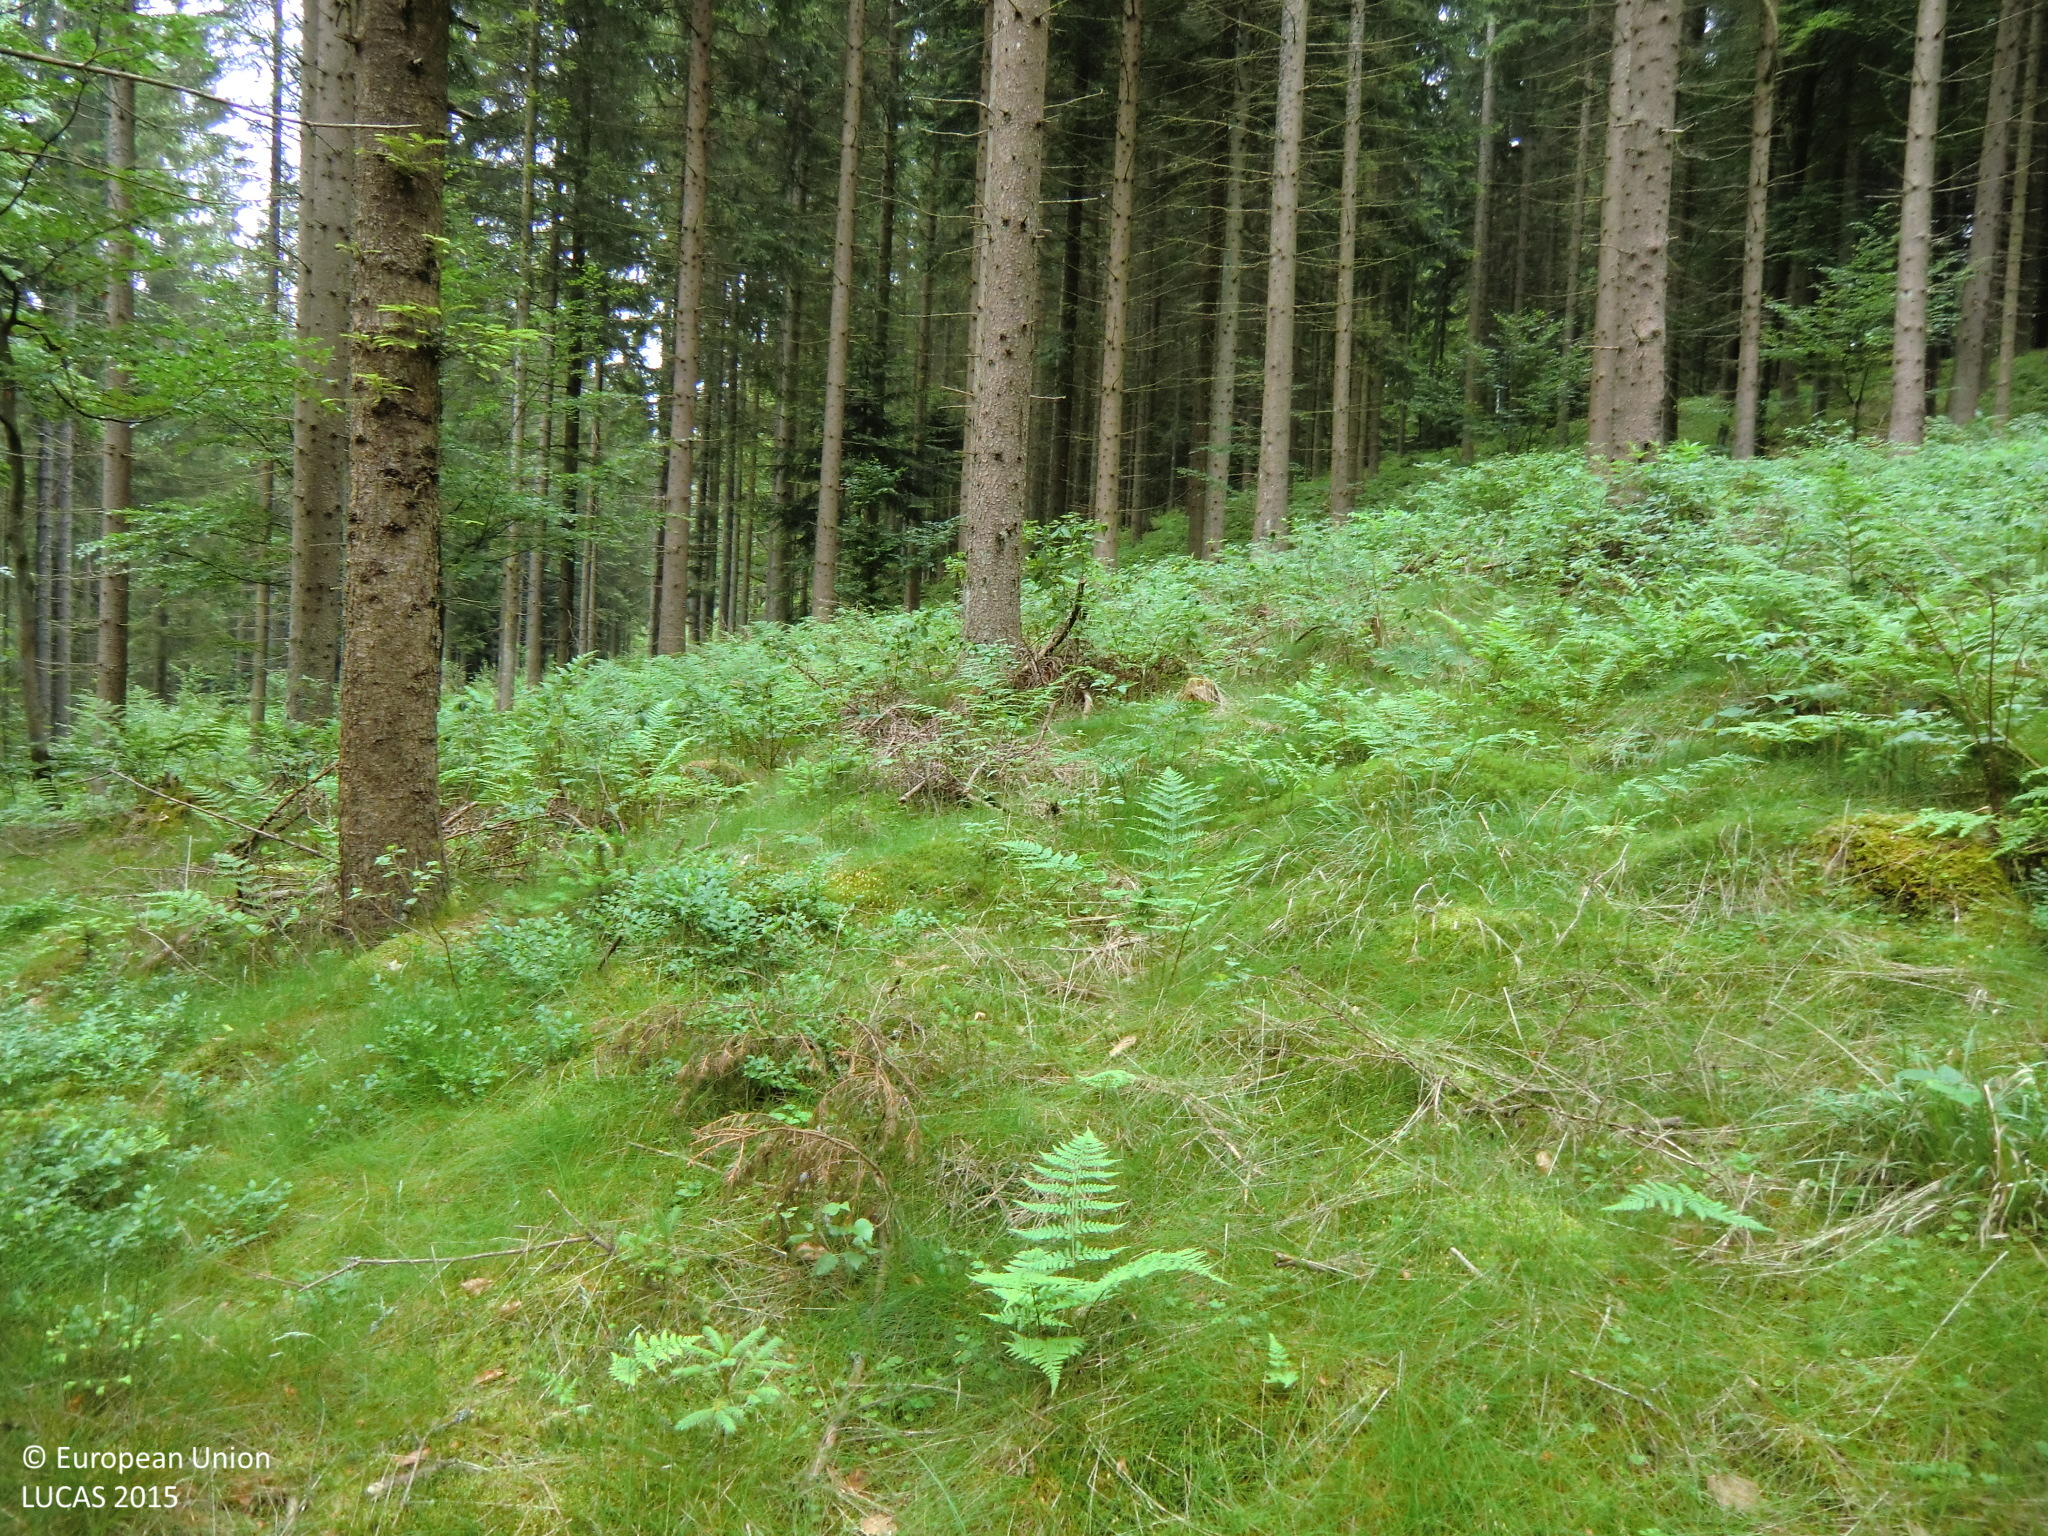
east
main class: Woodland
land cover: Spruce dominated coniferous woodland
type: hemiboreal forest and nemoral coniferous forest and mixed broadleaved-coniferous forest
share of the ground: 50 - 75 %
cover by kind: coniferous forest trees 60 %, shrubs 15 %, herbaceous plants 15 %, lichens and mosses 10 %
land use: Forestry
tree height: > 5 m
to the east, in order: Spruce dominated coniferous woodland; Tracks; Spruce dominated coniferous woodland; Rivers and streams; Spruce dominated coniferous woodland; Tracks; Spruce dominated coniferous woodland; Rivers and streams; Grassland without tree/shrub cover; Spruce dominated mixed woodland
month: June
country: AT
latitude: 48.3693
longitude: 14.8473
